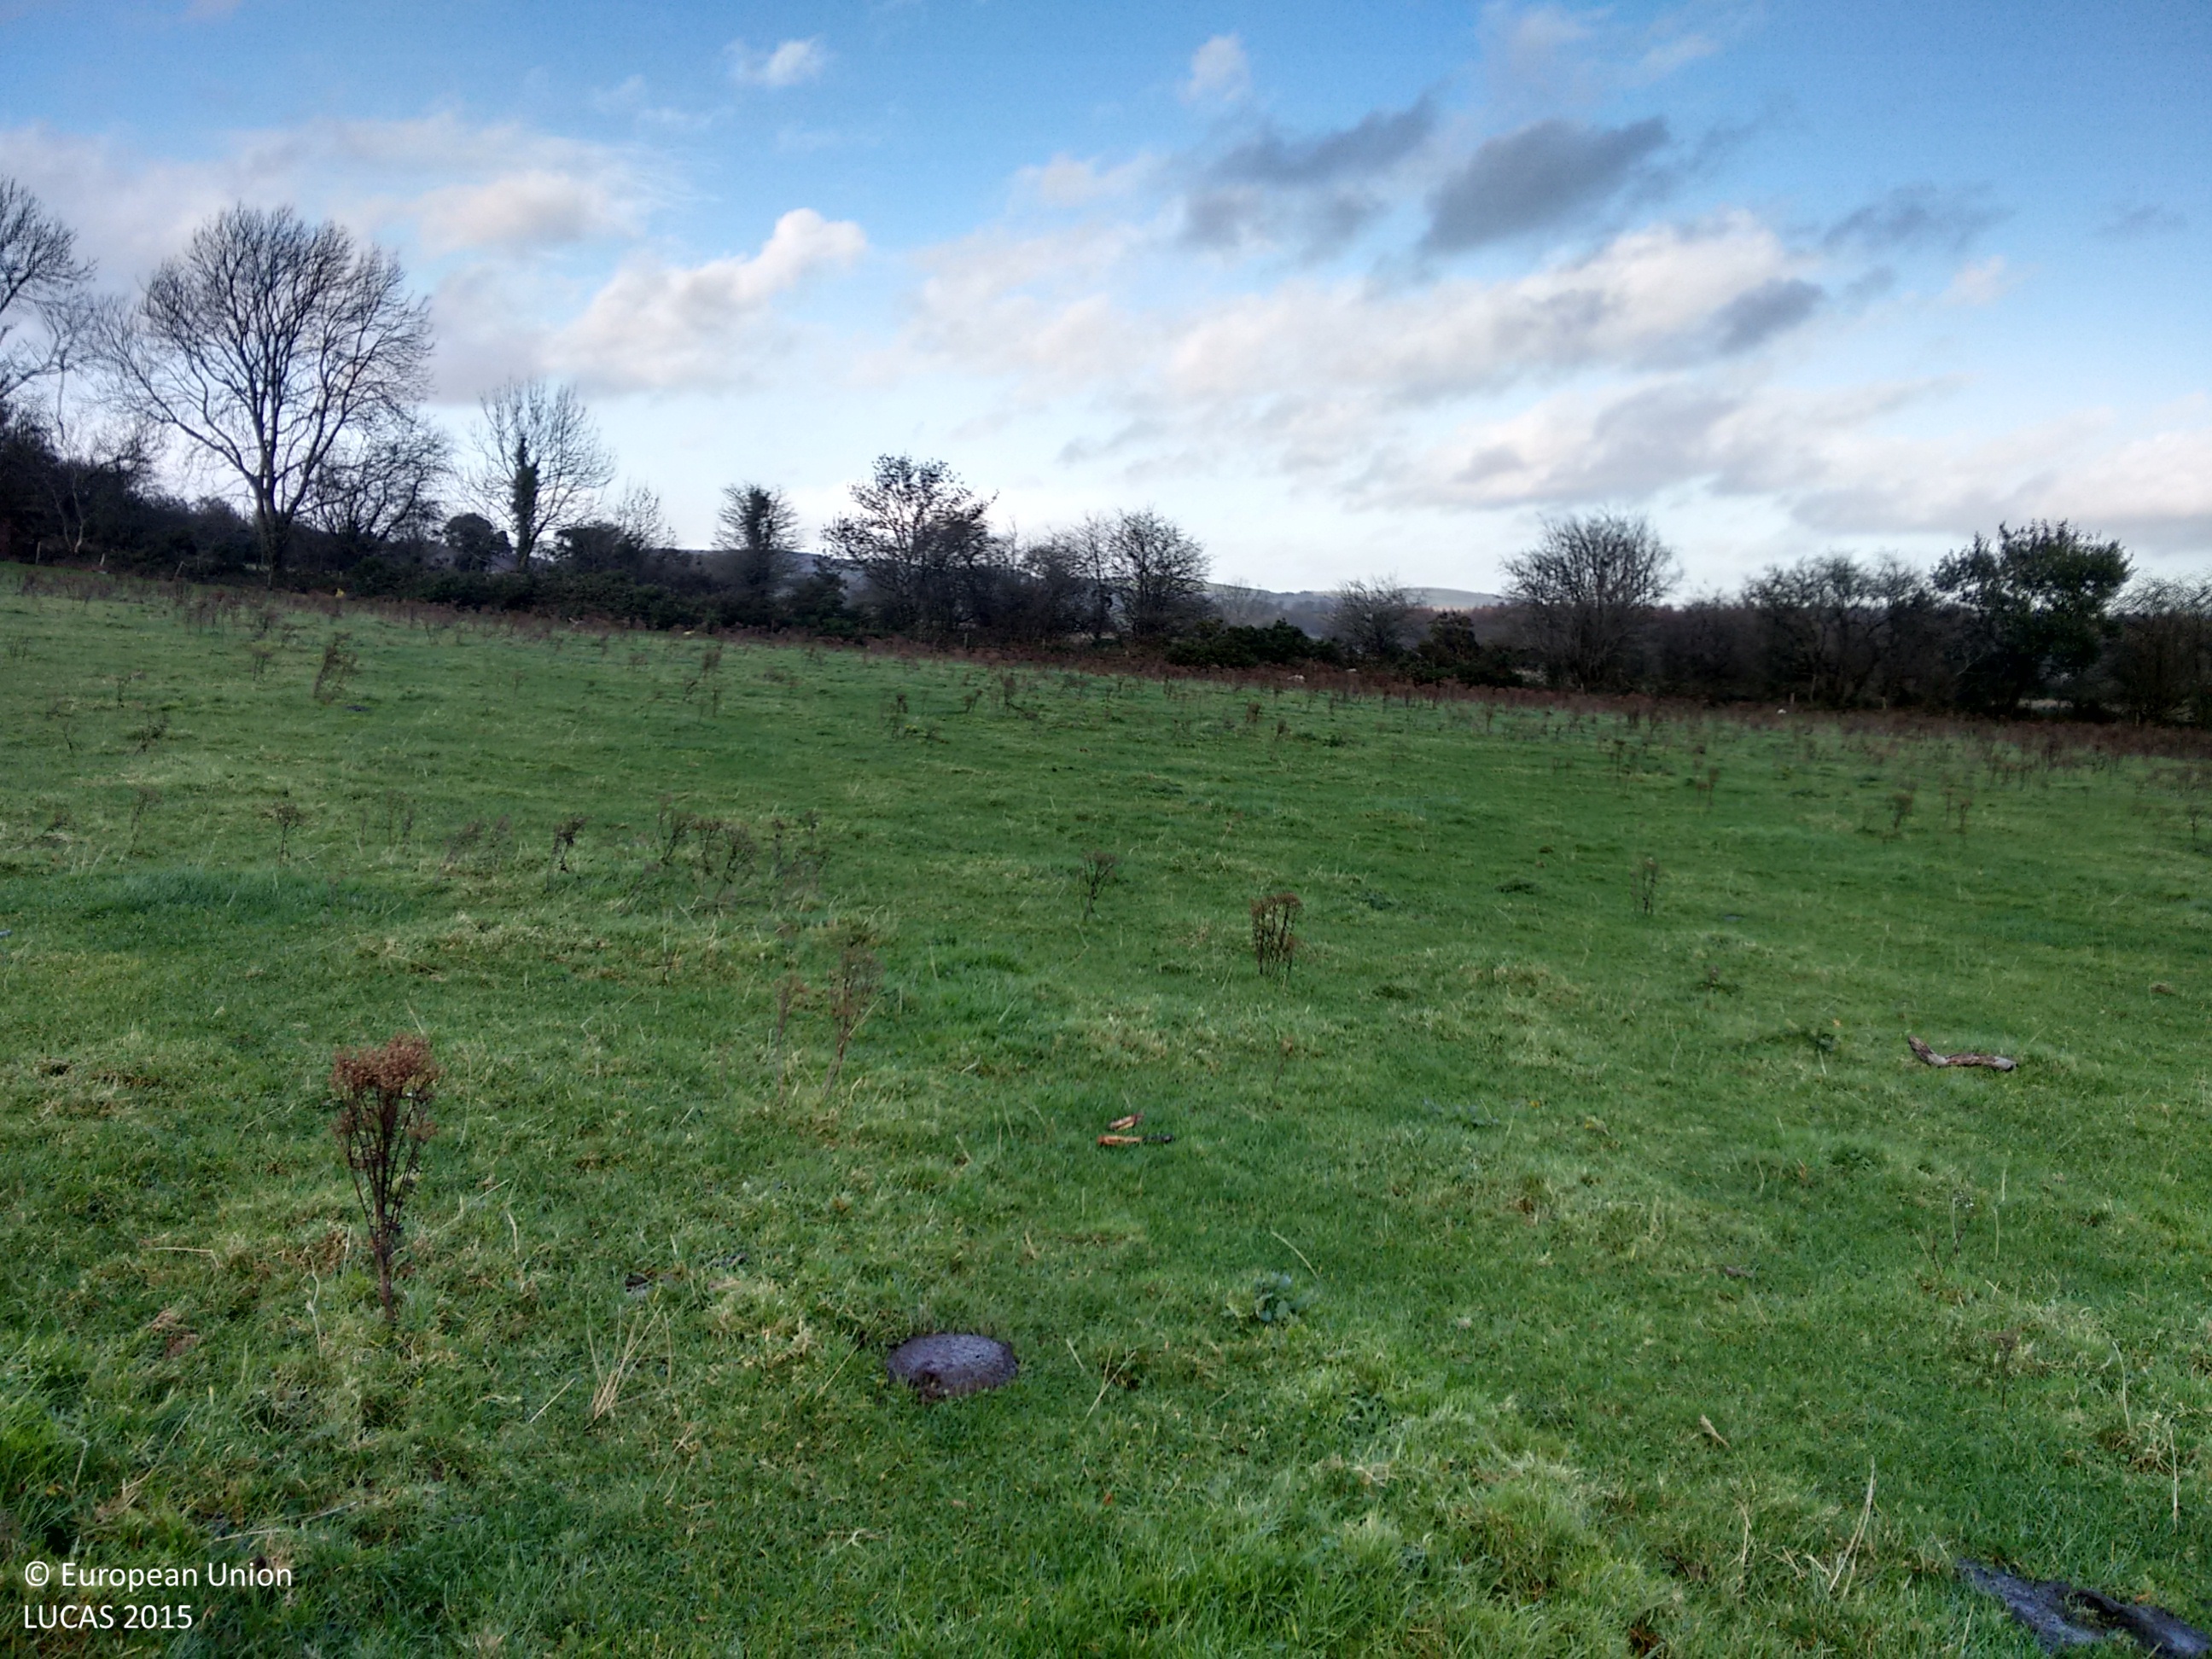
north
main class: Grassland
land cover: Grassland without tree/shrub cover
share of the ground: > 75 %
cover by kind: herbaceous plants 100 %
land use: Agriculture (excluding fallow land and kitchen gardens)
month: November
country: IE
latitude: 53.1504
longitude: -6.5619
